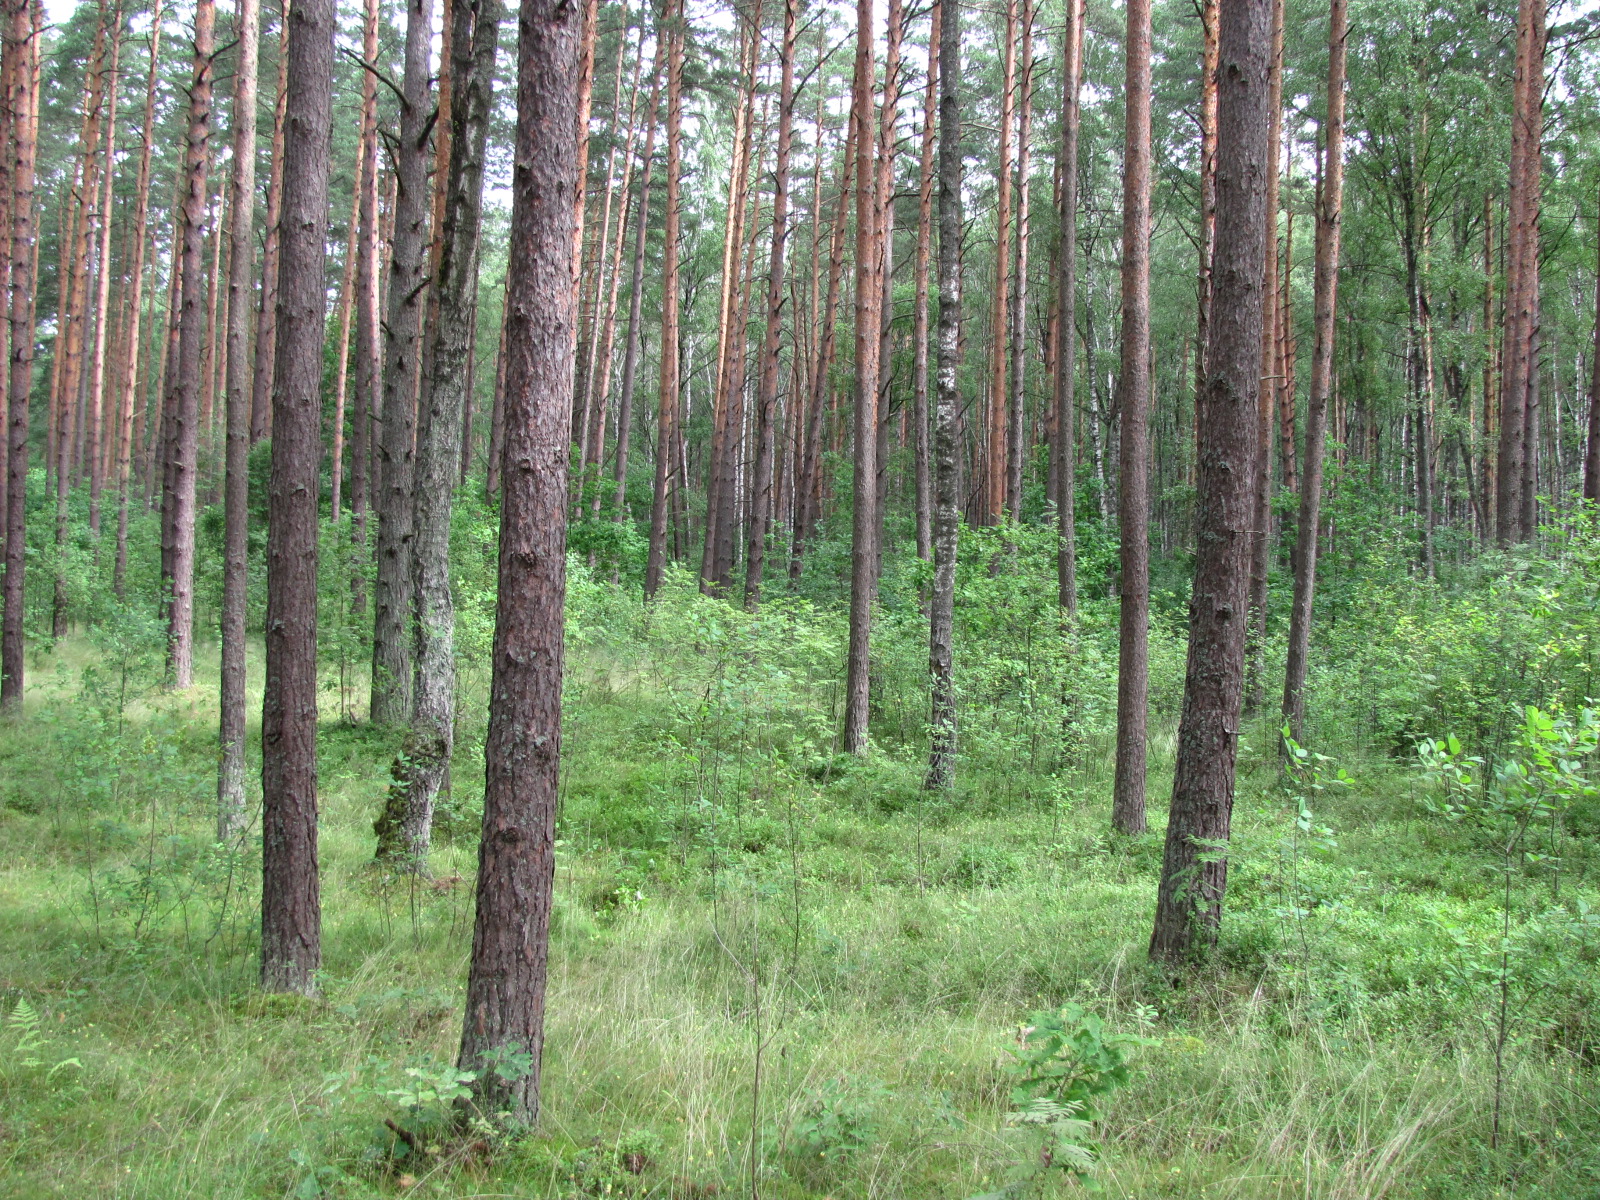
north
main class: Woodland
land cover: Pine dominated coniferous woodland
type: hemiboreal forest and nemoral coniferous forest and mixed broadleaved-coniferous forest
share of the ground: > 75 %
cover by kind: coniferous forest trees 80 %, shrubs 10 %, herbaceous plants 10 %
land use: Forestry
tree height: > 5 m
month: July
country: LV
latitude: 57.0626
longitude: 24.1520
